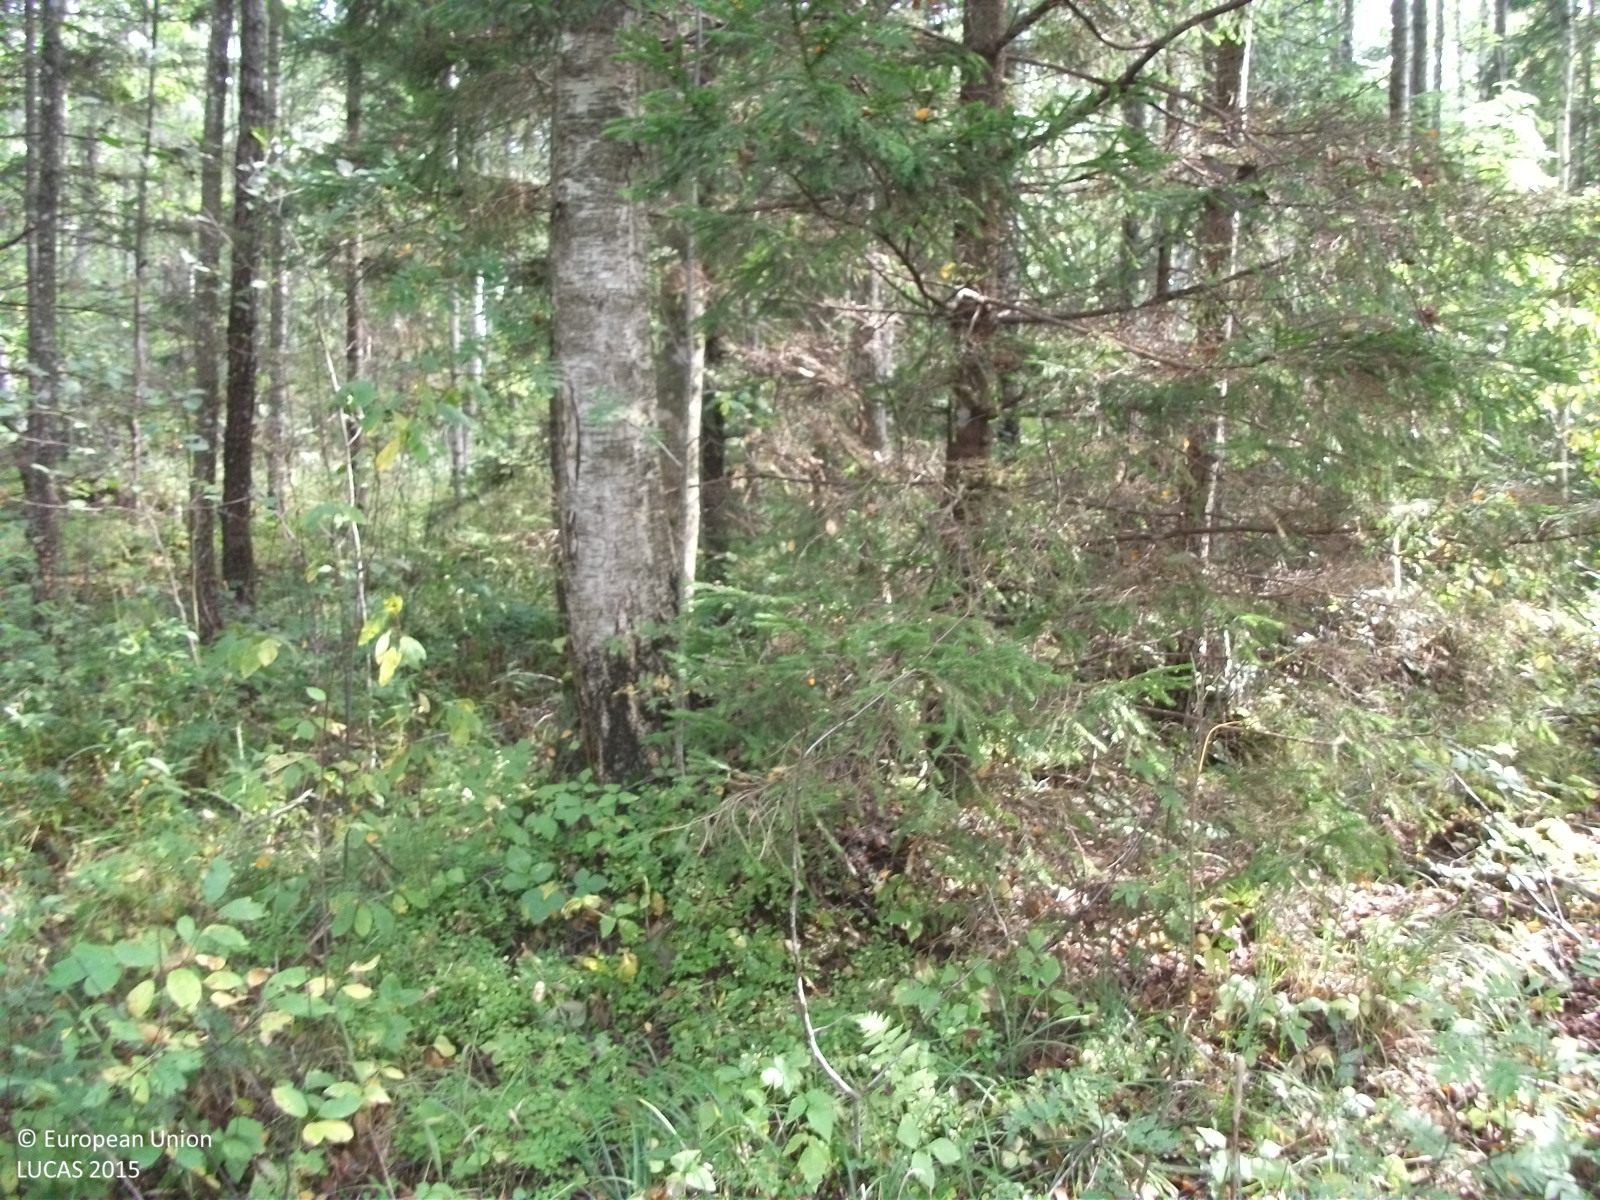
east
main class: Woodland
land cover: Spruce dominated mixed woodland
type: hemiboreal forest and nemoral coniferous forest and mixed broadleaved-coniferous forest
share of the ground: > 75 %
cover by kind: broadleaved forest trees 65 %, coniferous forest trees 25 %, shrubs 5 %, herbaceous plants 5 %
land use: Forestry
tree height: > 5 m
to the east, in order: Spruce dominated mixed woodland; Broadleaved woodland; Spruce dominated coniferous woodland; Other mixed woodland; Broadleaved woodland
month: September
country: LV
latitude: 57.6416
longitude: 24.5484
